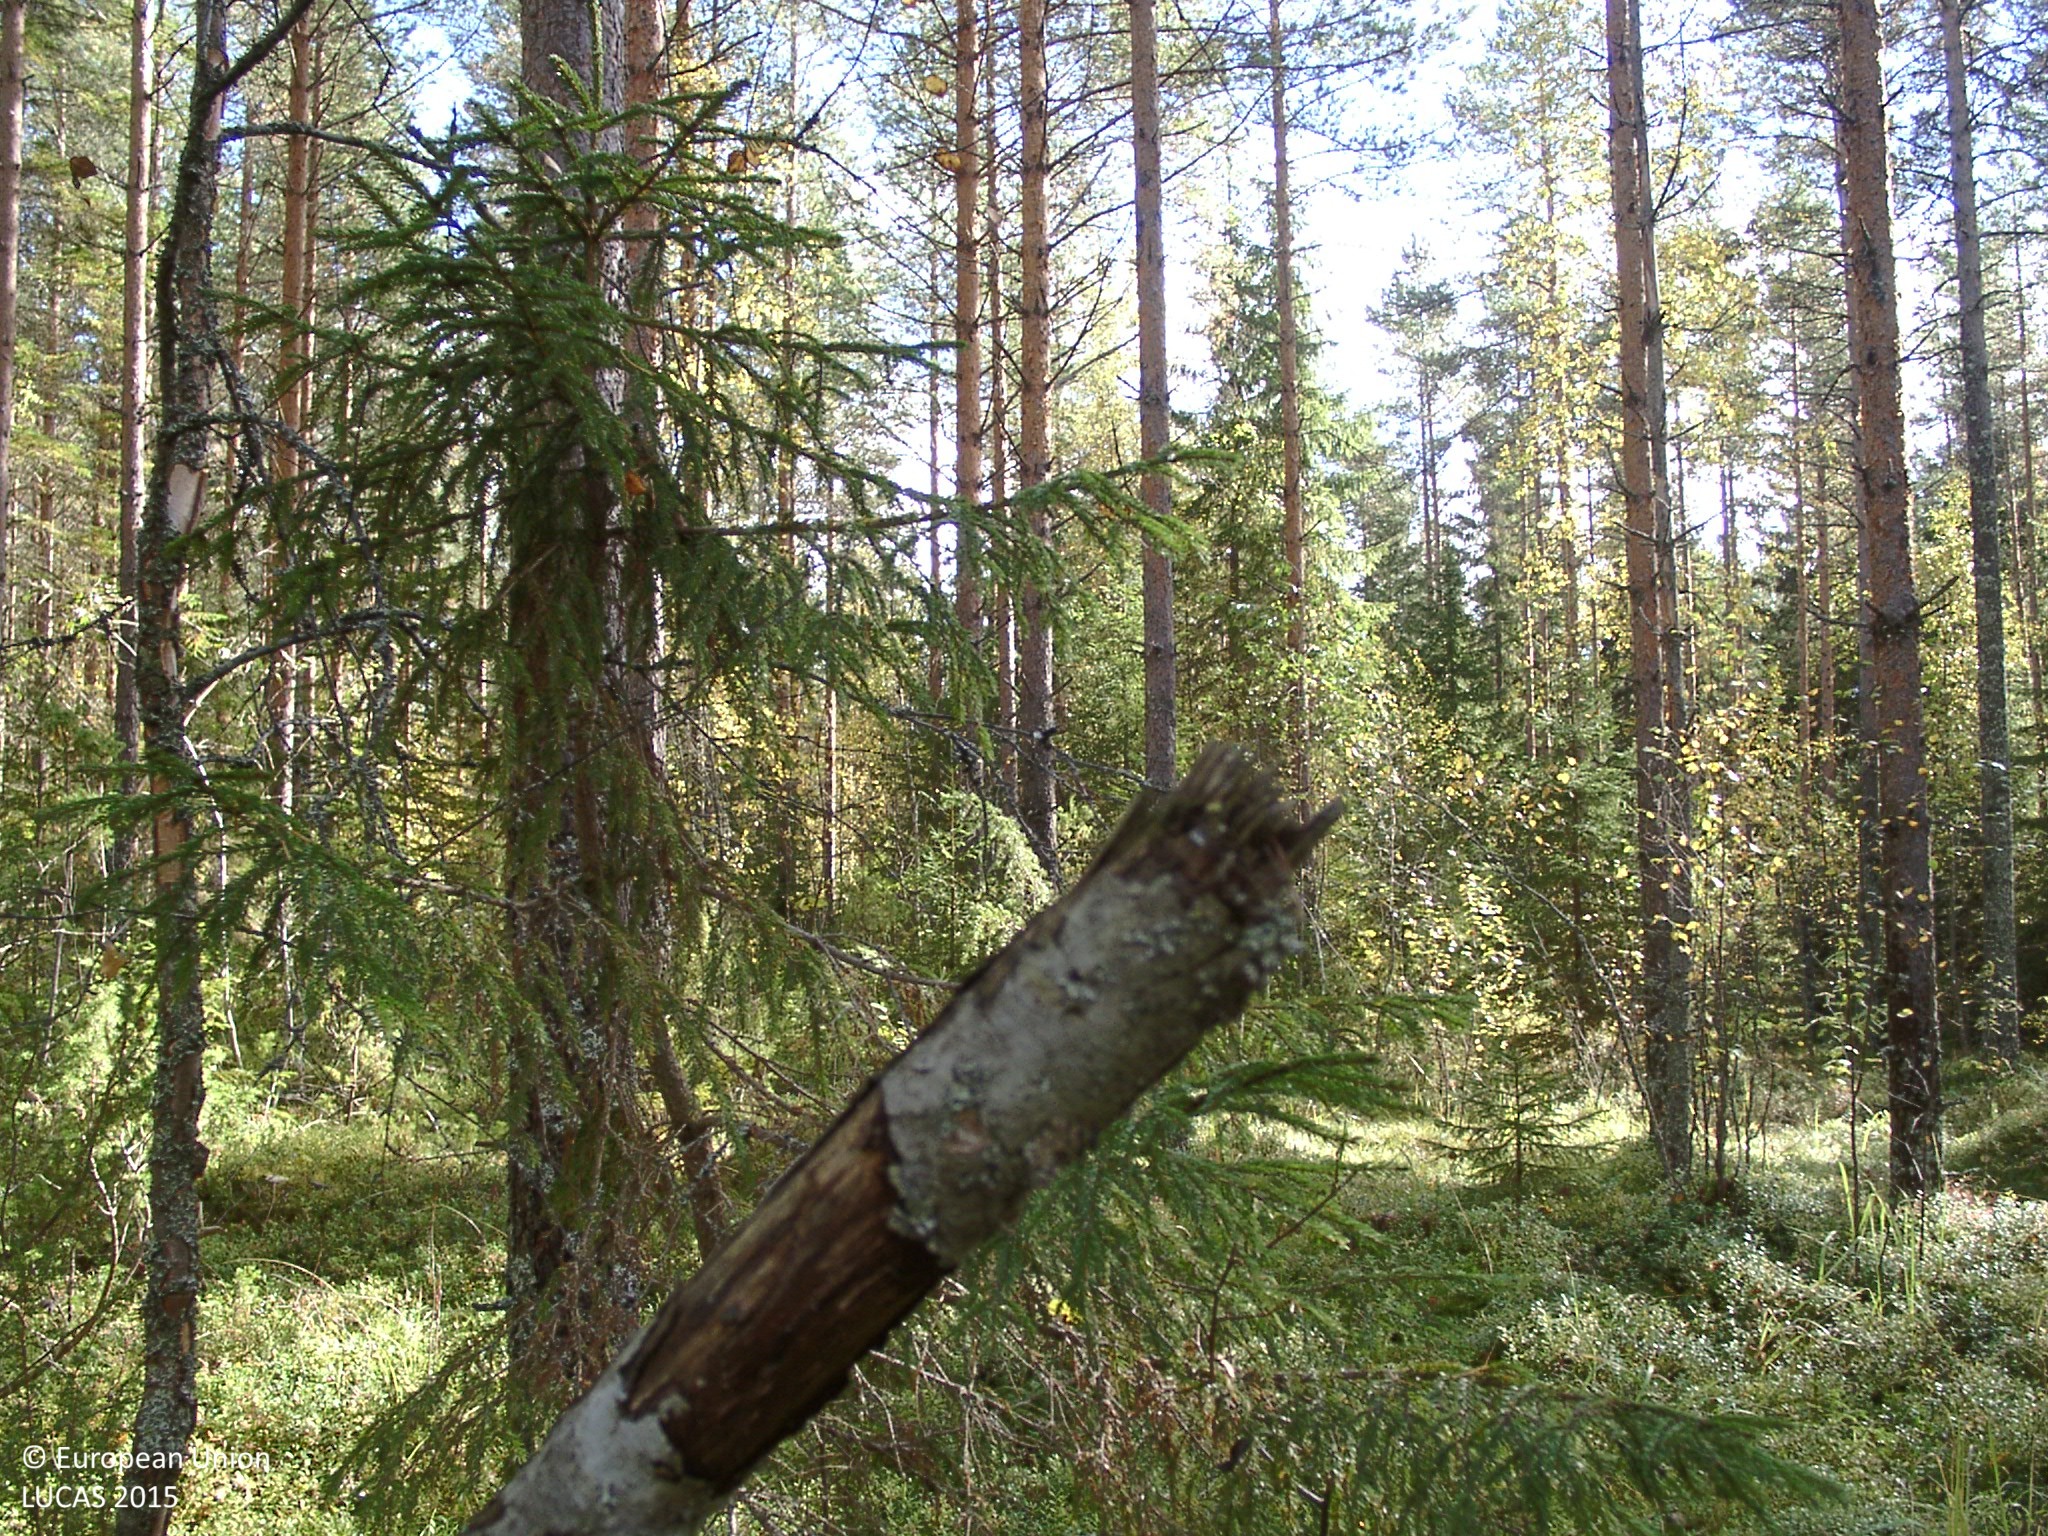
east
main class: Woodland
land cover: Pine dominated coniferous woodland
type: boreal forest
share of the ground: 50 - 75 %
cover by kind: coniferous forest trees 55 %, shrubs 25 %, broadleaved forest trees 10 %, herbaceous plants 5 %, lichens and mosses 5 %
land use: Forestry
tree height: > 5 m
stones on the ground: < 10 %
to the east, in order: Pine dominated coniferous woodland; Other coniferous woodland; Tracks; Spruce dominated mixed woodland; Ditches and canals; Spruce dominated mixed woodland; Ditches and canals; Spruce dominated mixed woodland; Other mixed woodland; Spruce dominated mixed woodland; Ditches and canals; Spruce dominated mixed woodland; Other mixed woodland
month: September
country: FI
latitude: 62.5260
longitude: 25.2808
